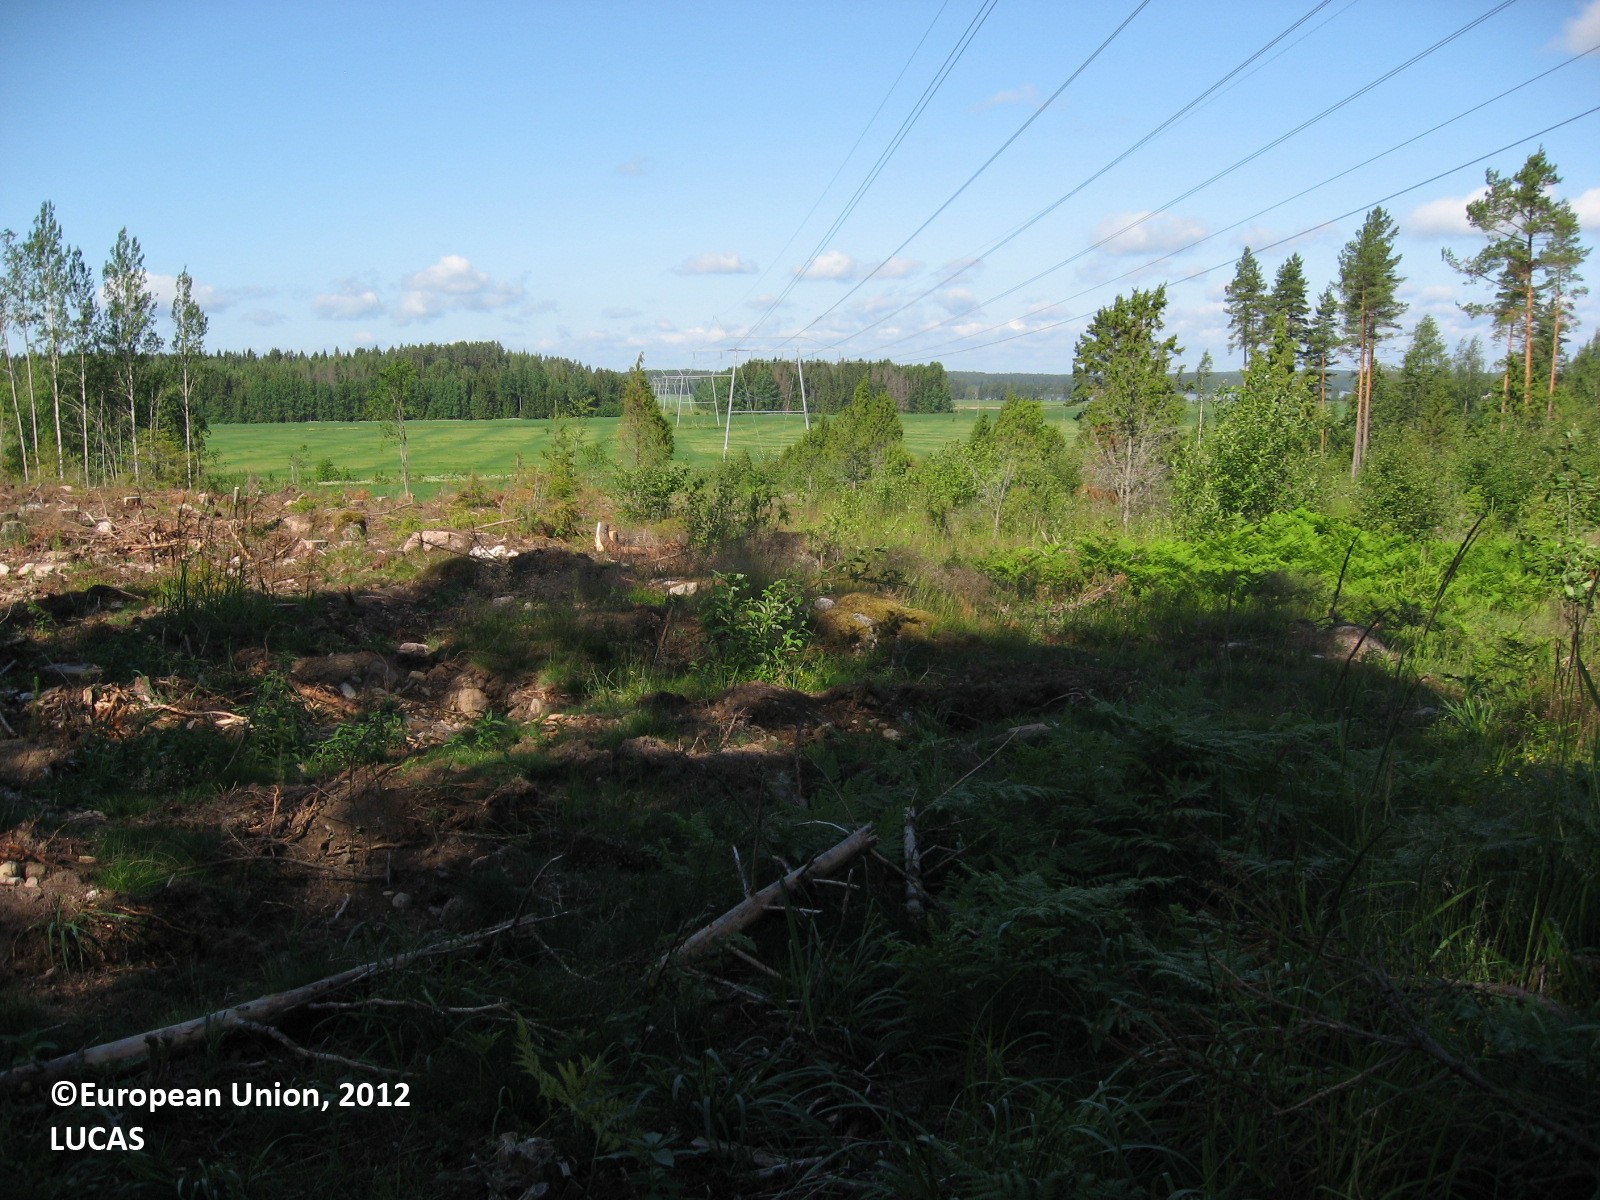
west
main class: Grassland
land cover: Grassland with sparse tree/shrub cover
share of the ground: 50 - 75 %
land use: Forestry
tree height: < 5 m
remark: Clear cut
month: July
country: FI
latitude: 60.8129
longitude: 26.2688
